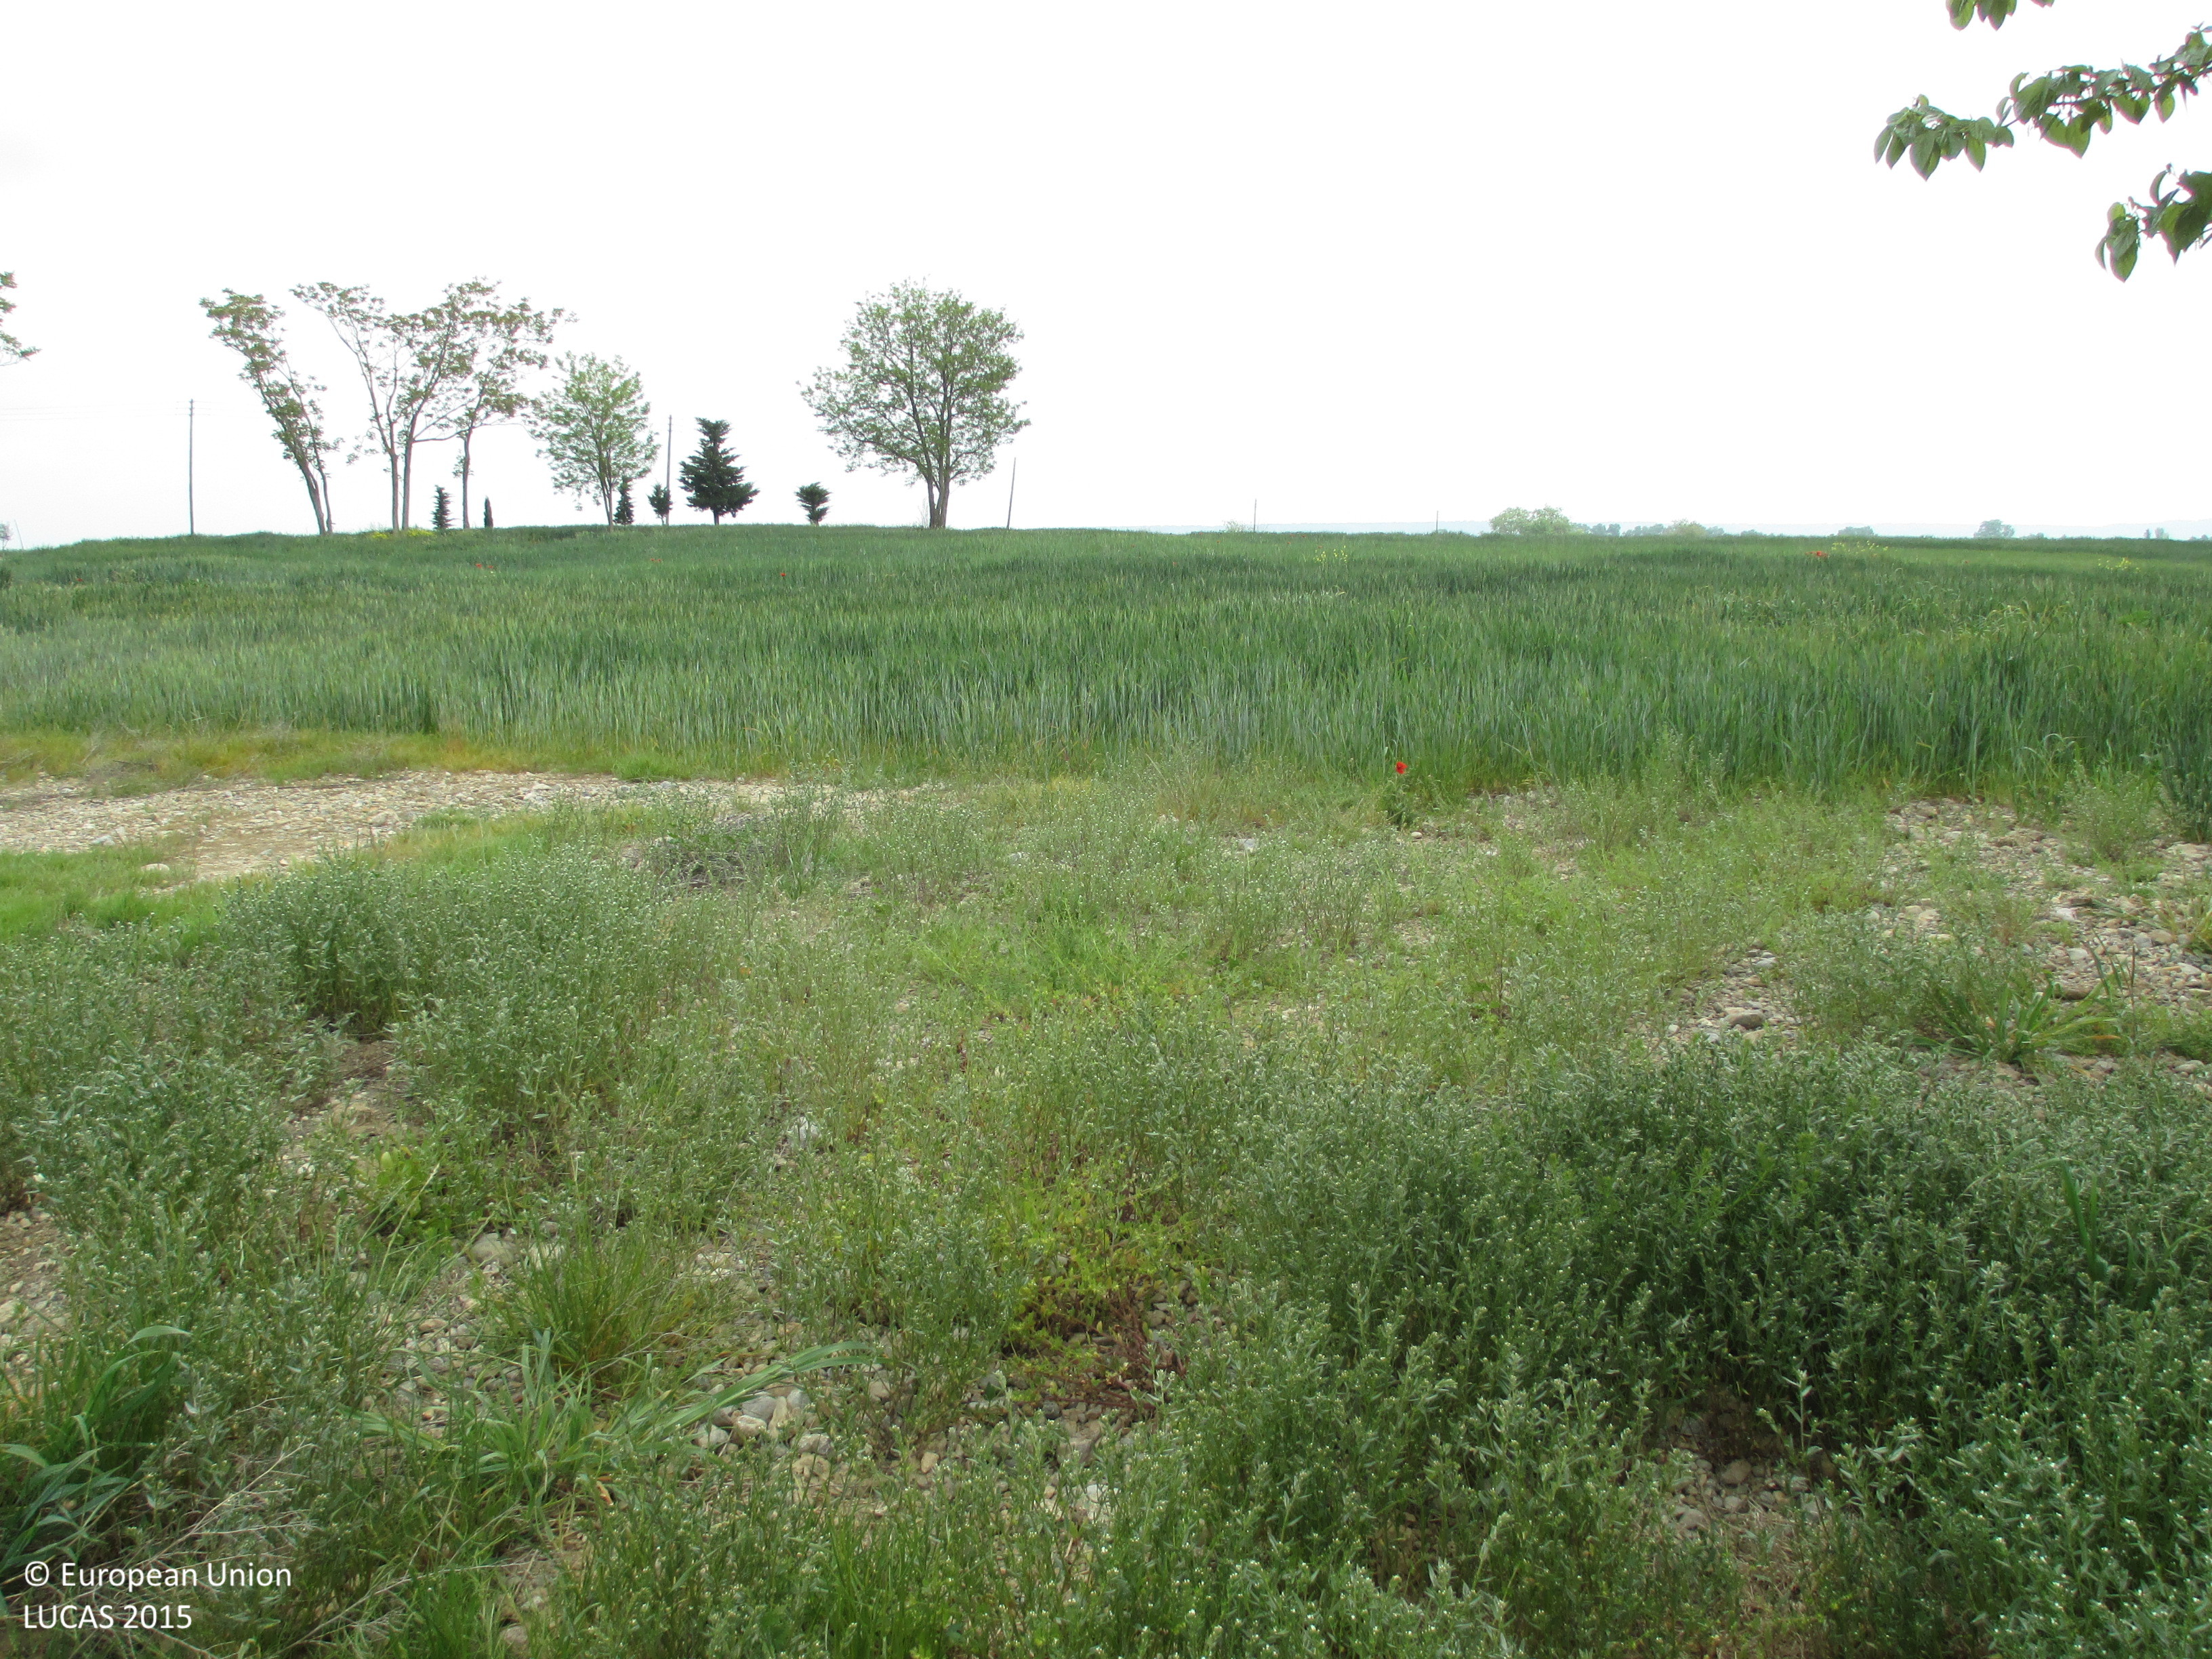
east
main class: Cropland
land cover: Durum wheat
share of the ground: > 75 %
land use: Agriculture (excluding fallow land and kitchen gardens)
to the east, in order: Durum wheat; Grassland with sparse tree/shrub cover; Durum wheat; Grass margins; Paved roads, cycling and walking lanes; Grass margins; Dry pulses; Grass margins; Barley
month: April
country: ES
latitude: 42.0981
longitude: -0.4087
